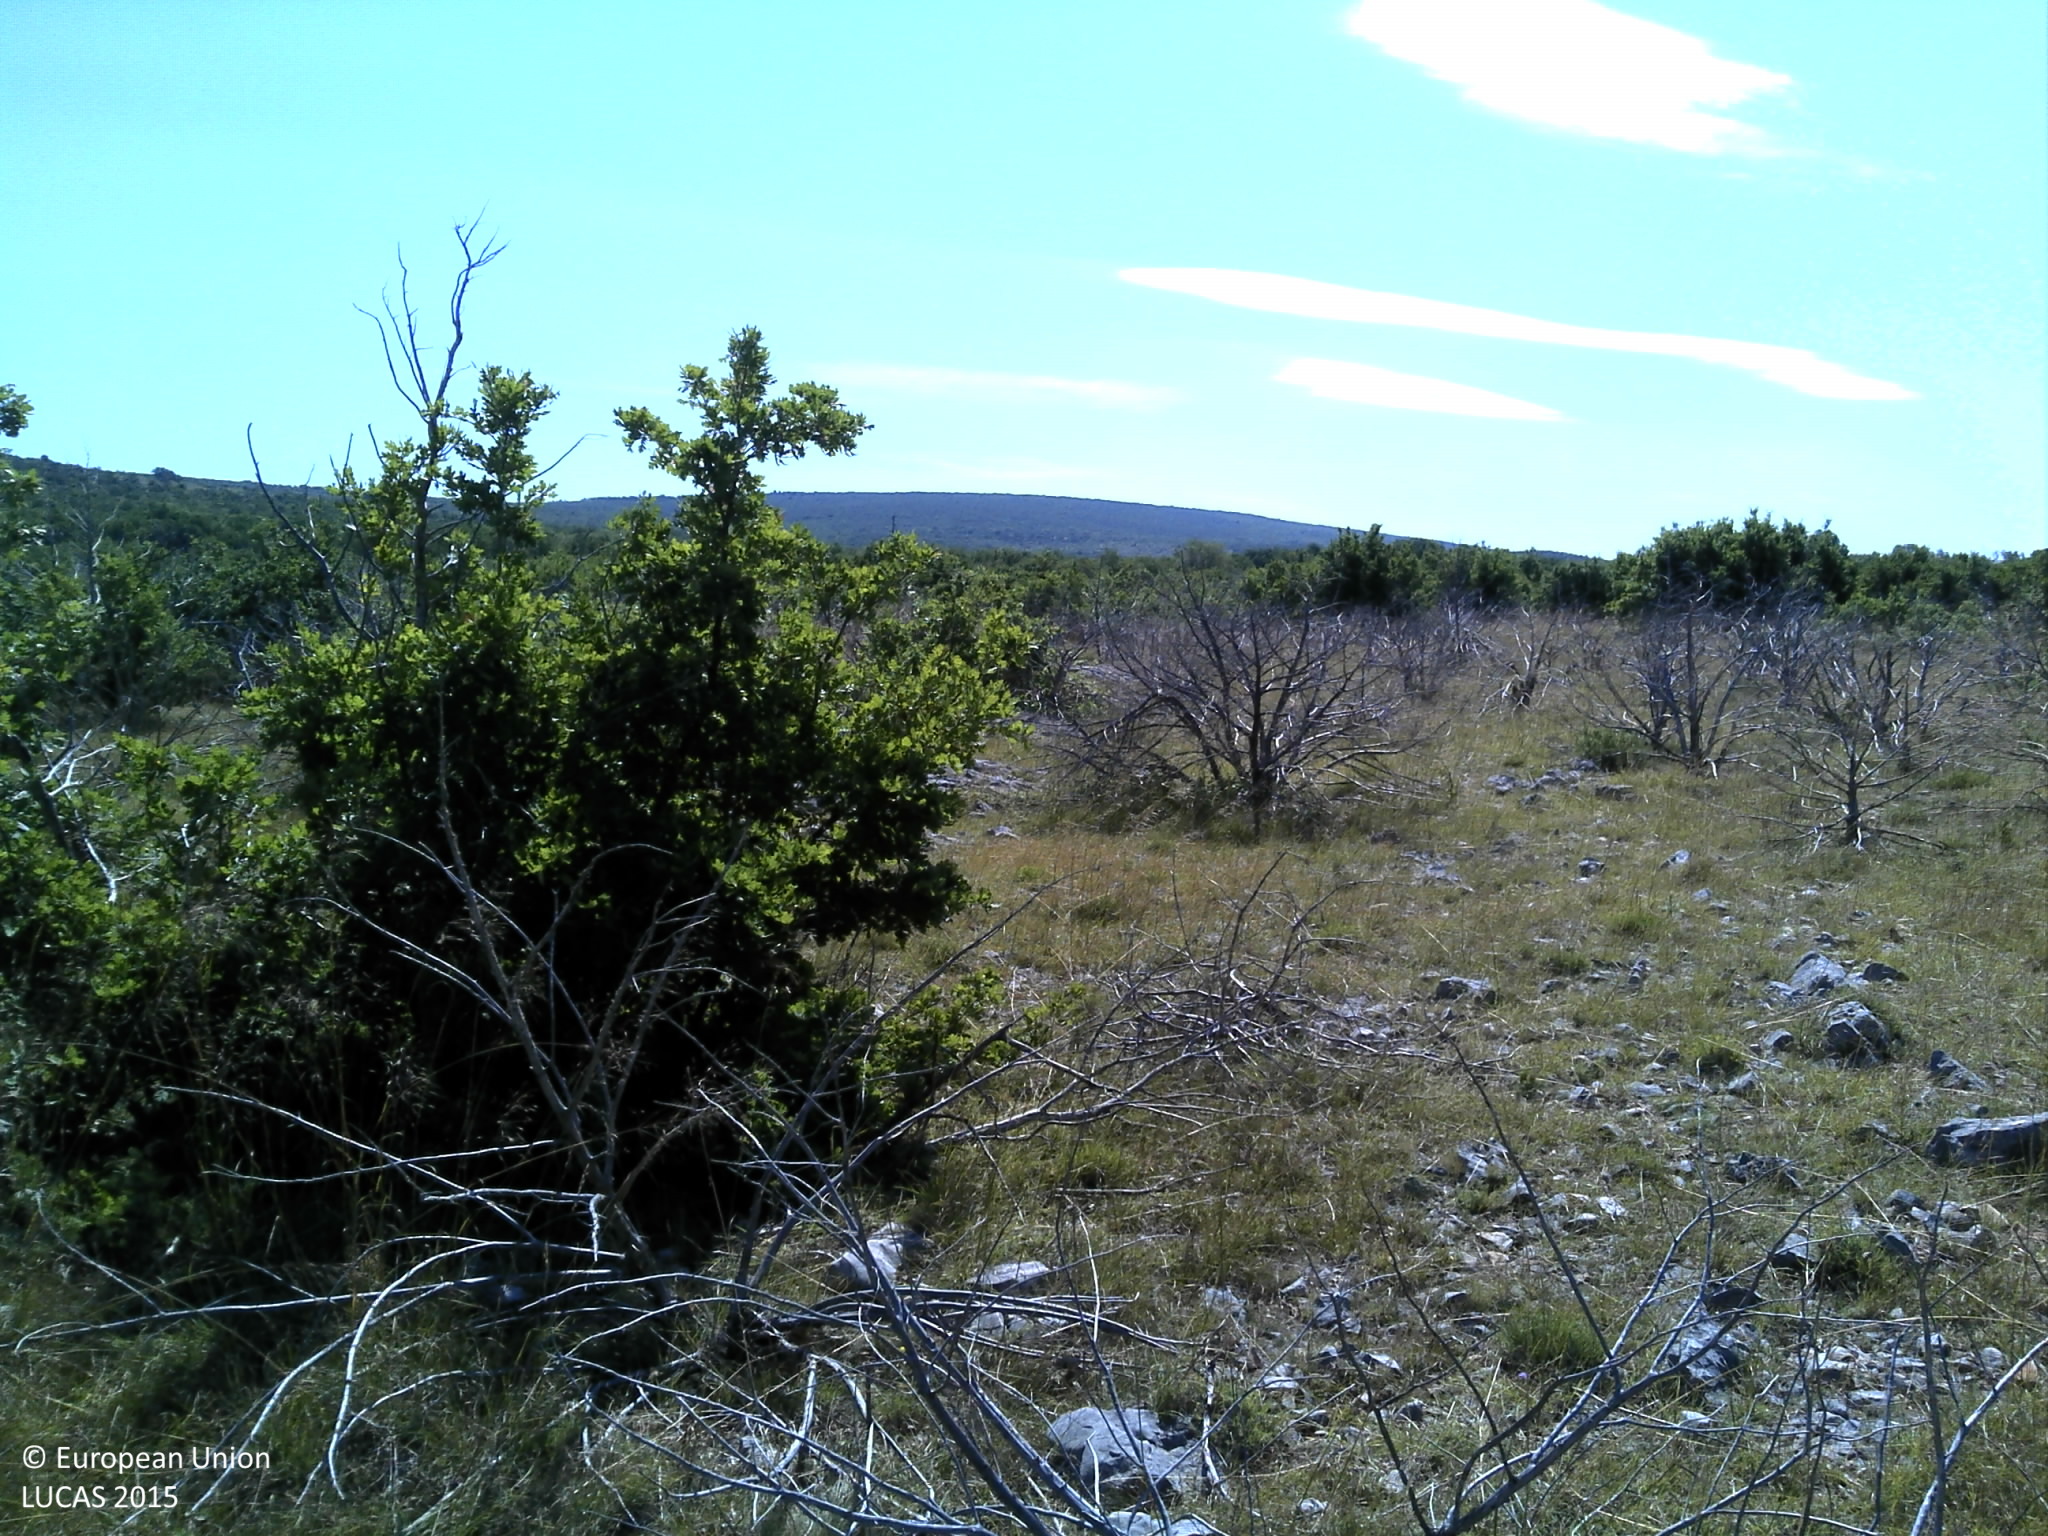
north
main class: Shrubland
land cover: Shrubland without tree cover
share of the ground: 25 - 50 %
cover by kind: herbaceous plants 40 %, shrubs 30 %, unconsolidated bare surface 25 %, consolidated bare surface 5 %
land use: Semi-natural and natural areas not in use
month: July
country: HR
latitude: 43.7931
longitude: 16.0686
